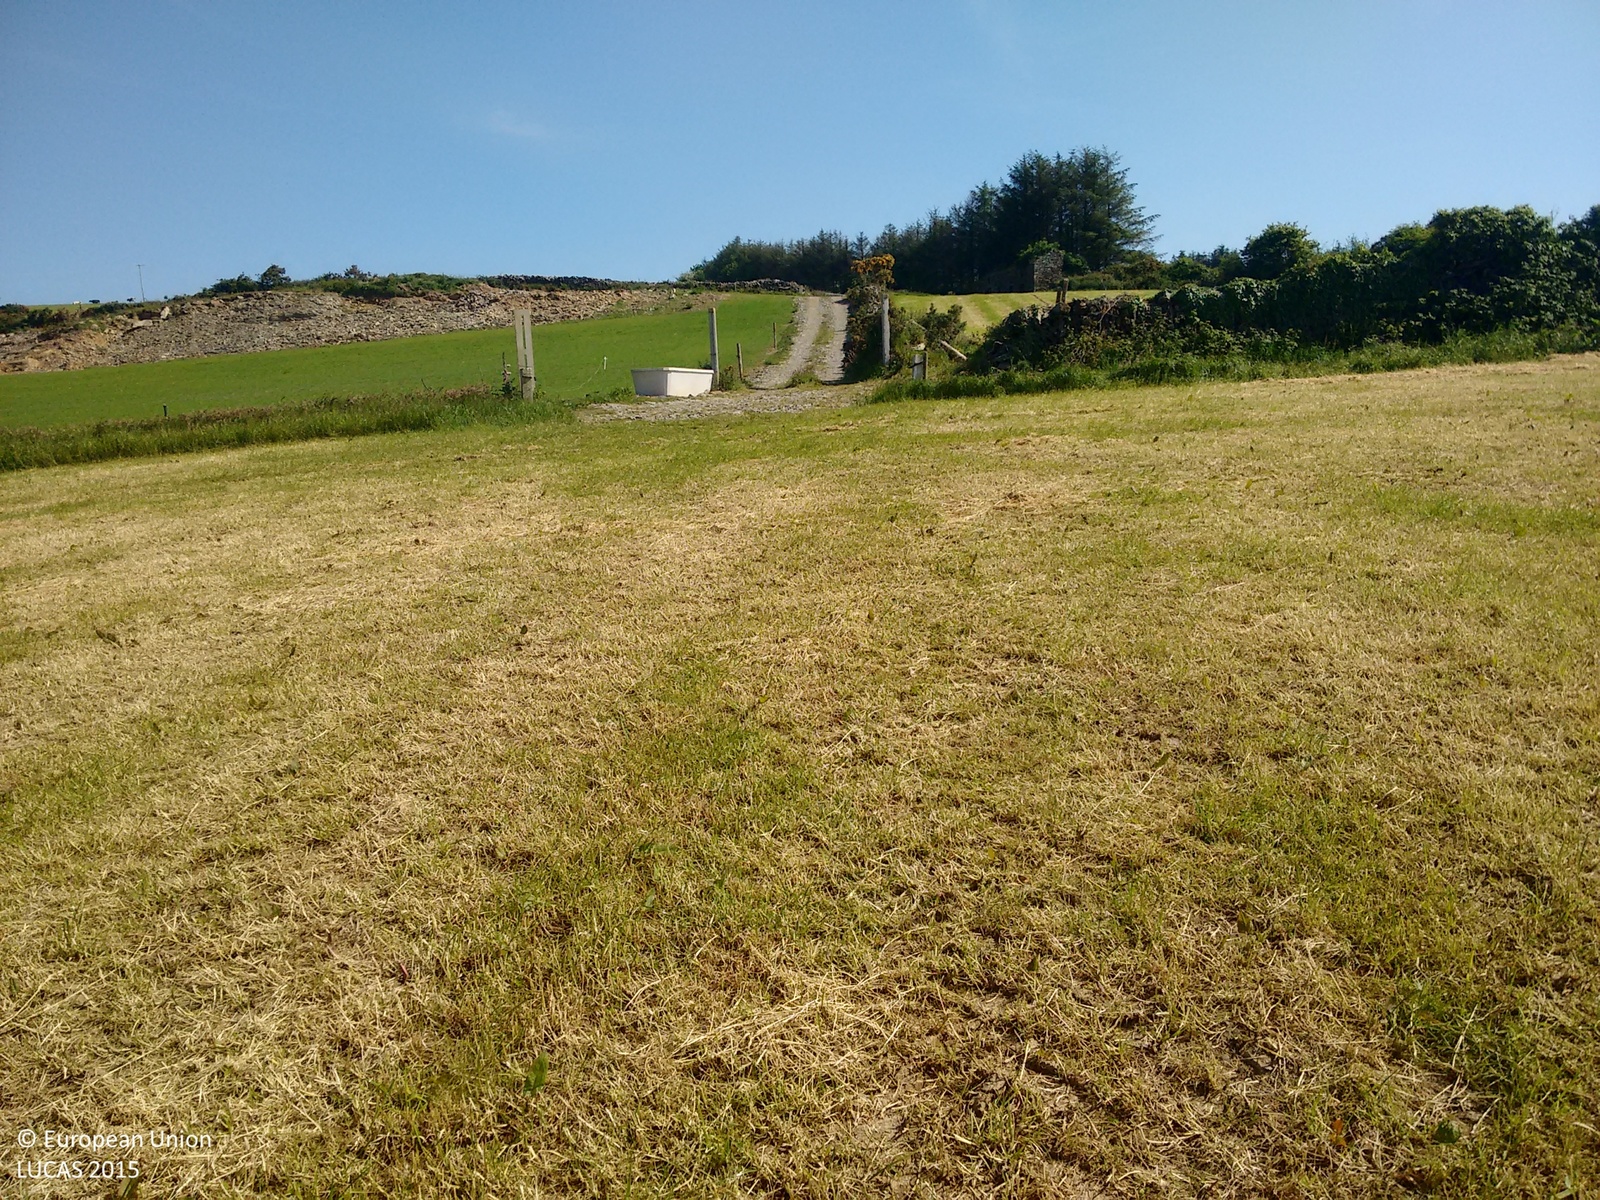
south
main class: Grassland
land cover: Grassland without tree/shrub cover
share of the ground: > 75 %
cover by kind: herbaceous plants 100 %
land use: Agriculture (excluding fallow land and kitchen gardens)
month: June
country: IE
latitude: 51.7227
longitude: -8.8076
